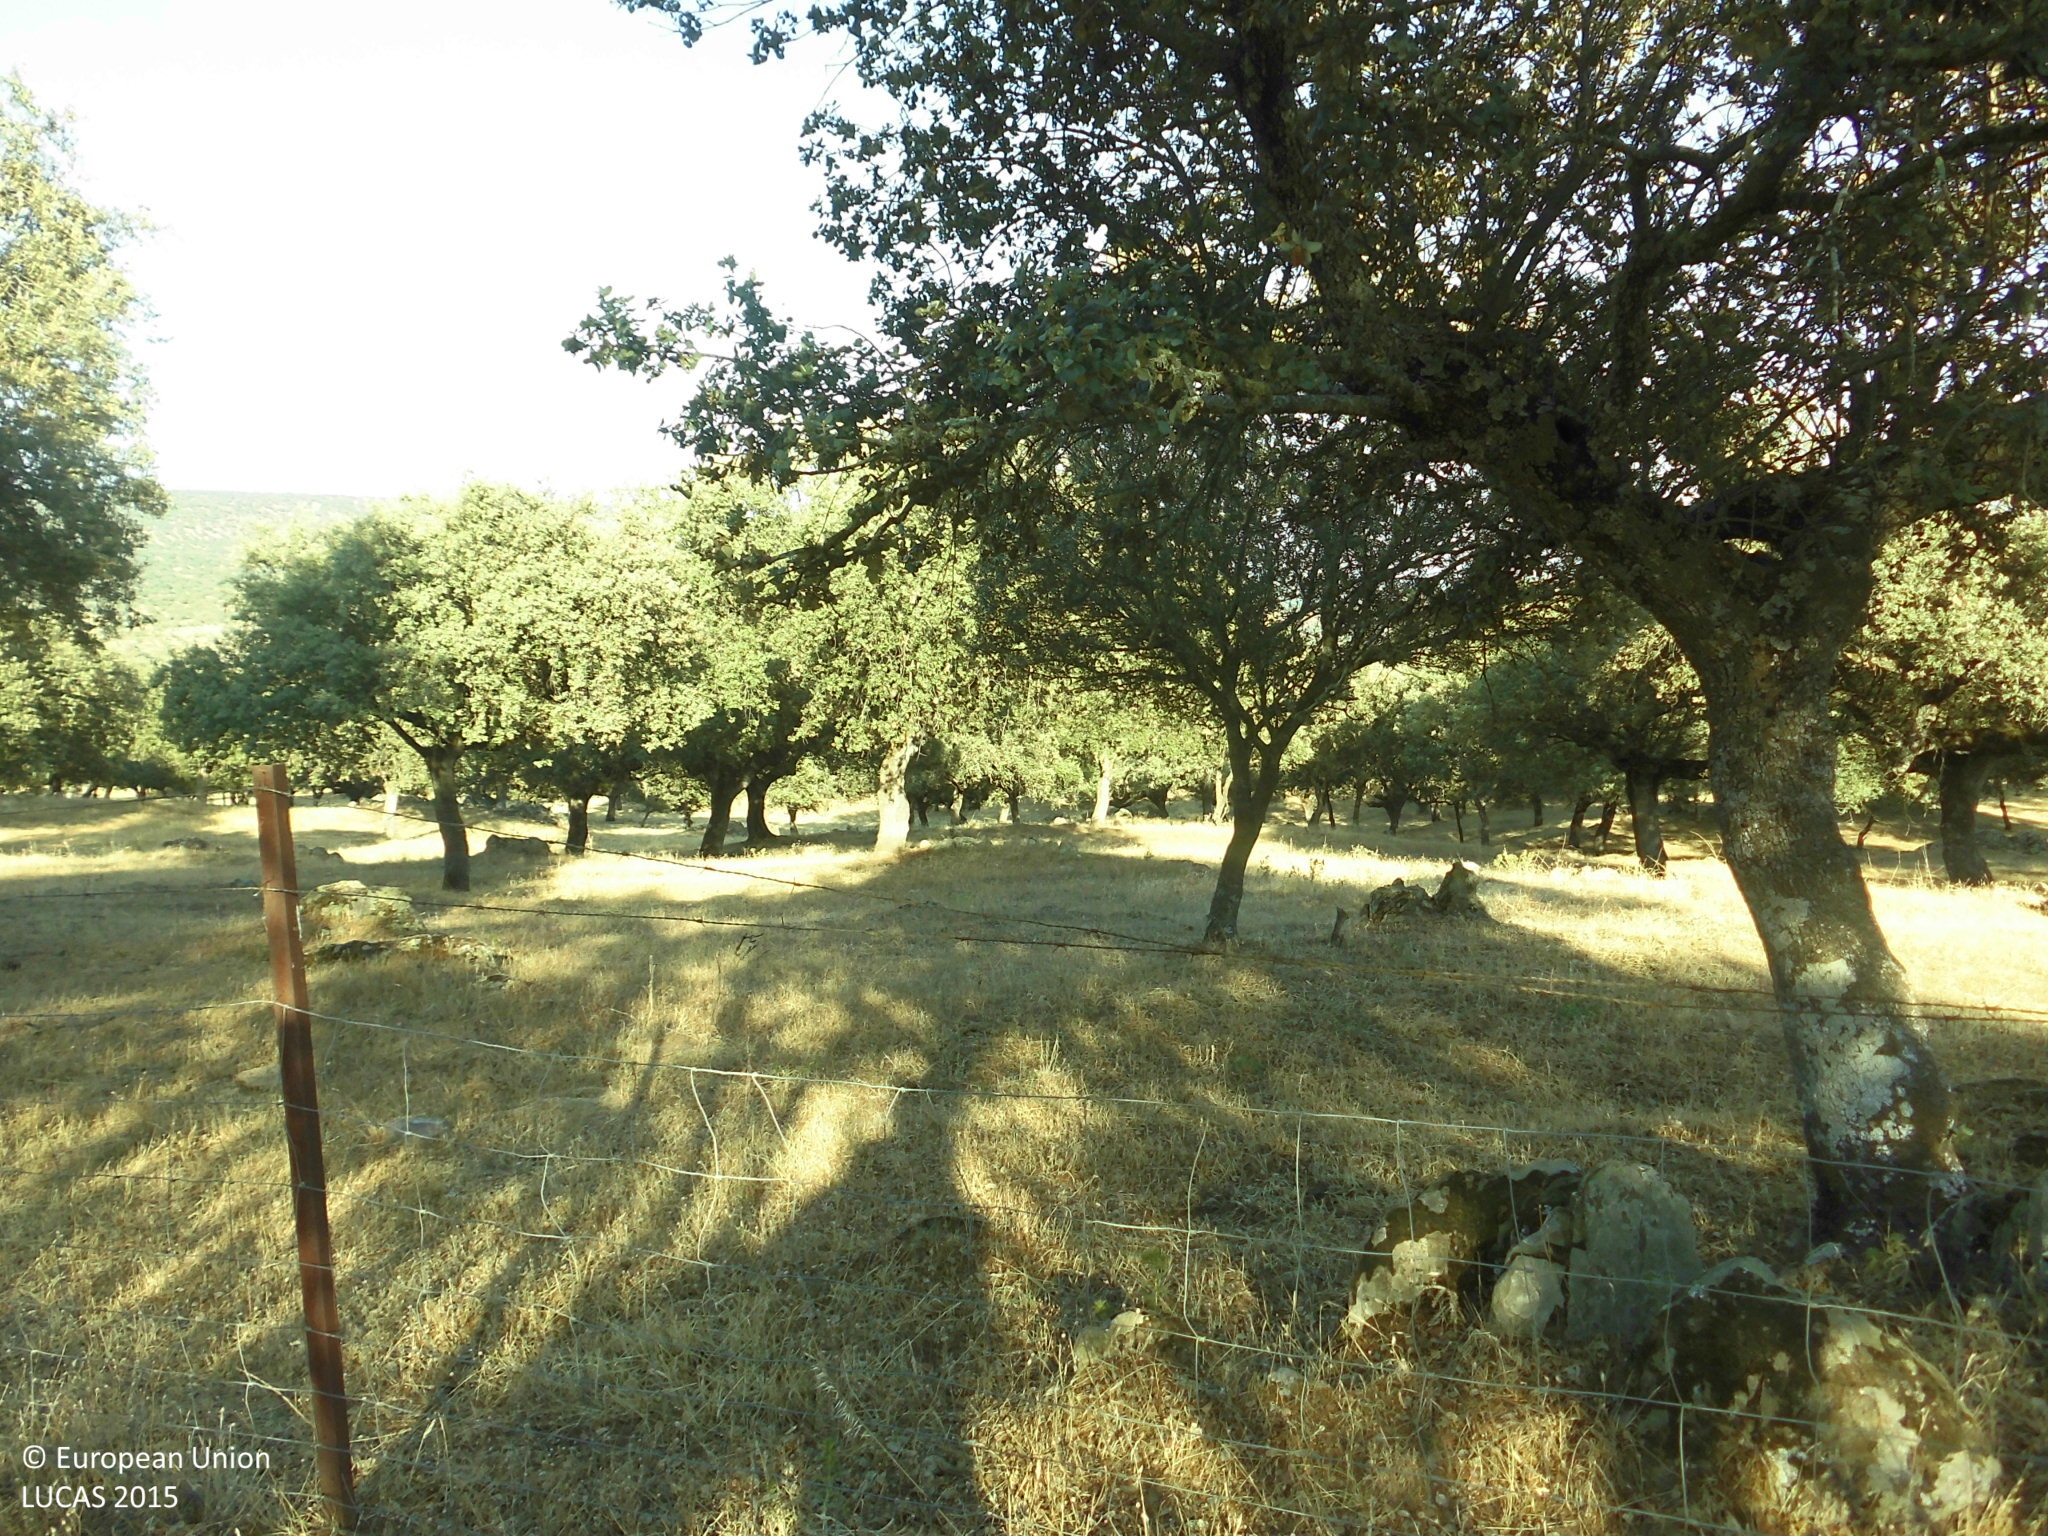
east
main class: Woodland
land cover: Broadleaved woodland
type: broadleaved evergreen forest
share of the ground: 25 - 50 %
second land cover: Grassland without tree/shrub cover
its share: > 75 %
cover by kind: broadleaved forest trees 50 %, herbaceous plants 50 %
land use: Forestry
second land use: Agriculture (excluding fallow land and kitchen gardens)
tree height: > 5 m
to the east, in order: Broadleaved woodland; Grassland without tree/shrub cover; Broadleaved woodland; Fences; Broadleaved woodland; Tracks; Broadleaved woodland
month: July
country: ES
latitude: 39.4928
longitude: -5.5762
